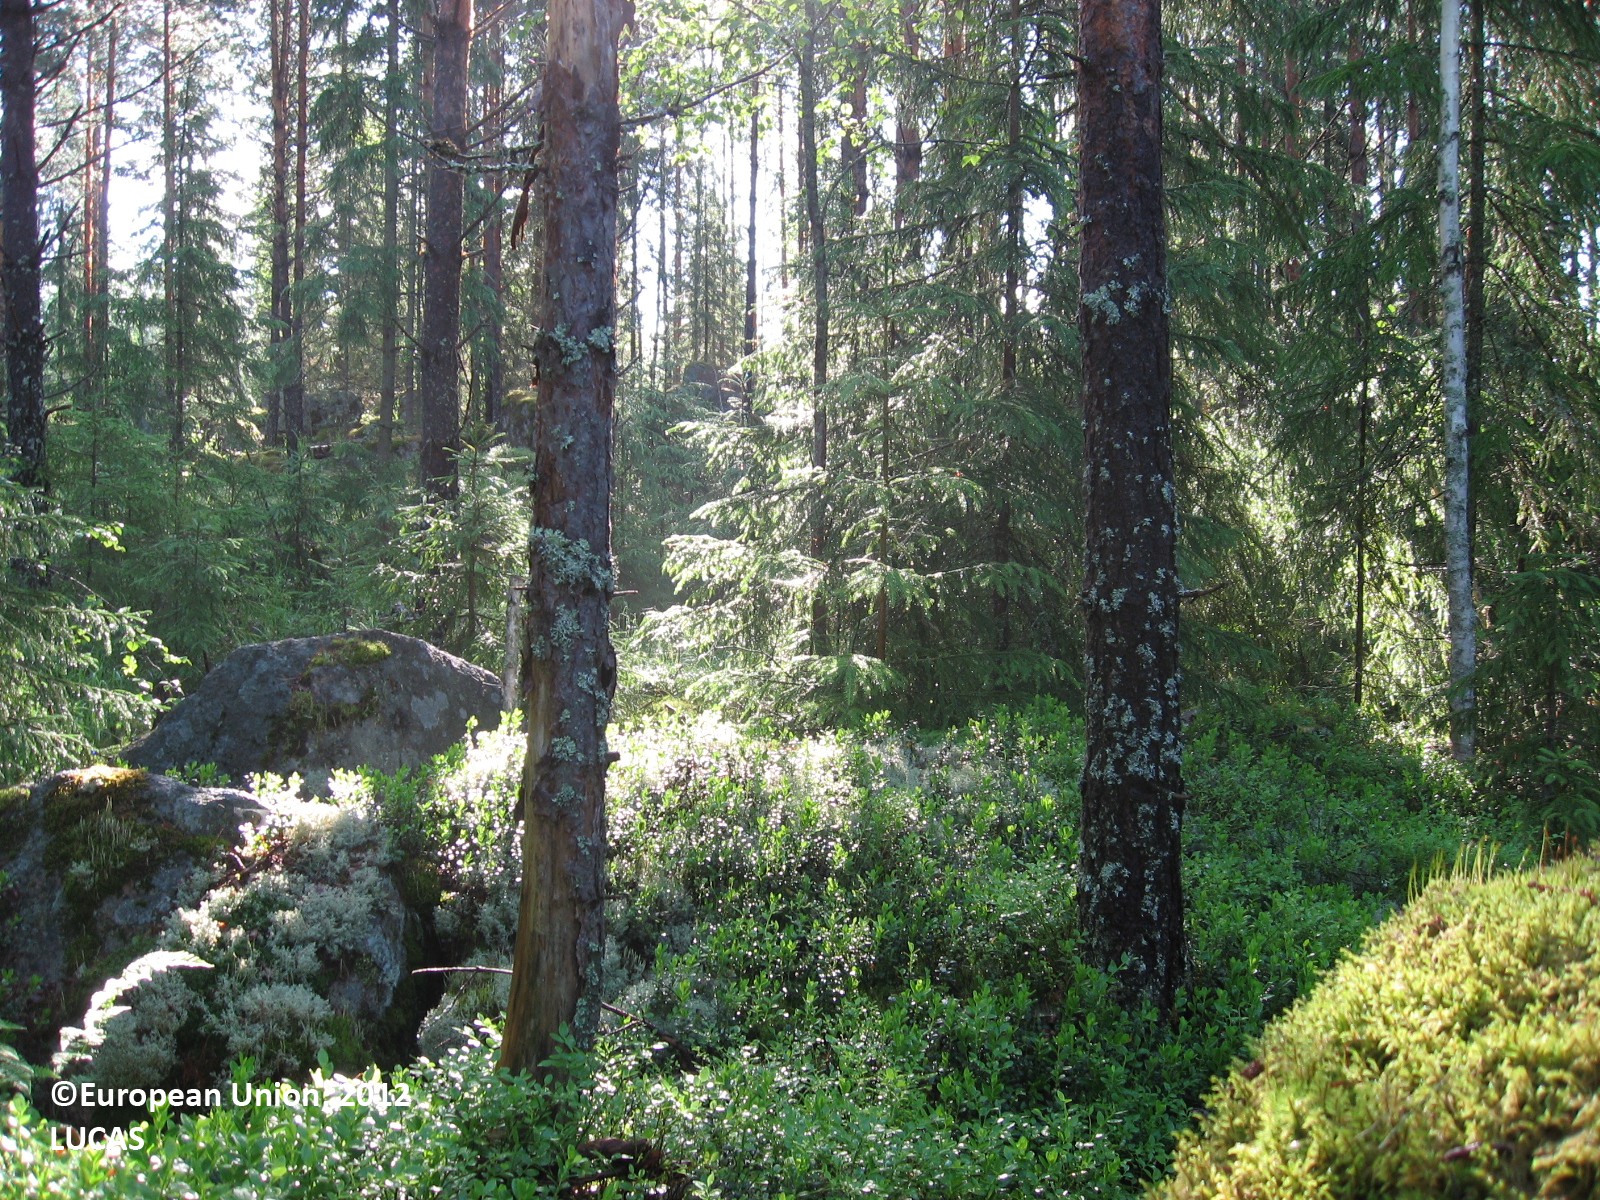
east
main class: Woodland
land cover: Other coniferous woodland
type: boreal forest
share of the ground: 25 - 50 %
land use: Forestry
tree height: > 5 m
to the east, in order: Other coniferous woodland; Spruce dominated mixed woodland; Pine dominated mixed woodland; Spruce dominated mixed woodland; Spontaneously vegetated surfaces; Spruce dominated mixed woodland; Broadleaved woodland
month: June
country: FI
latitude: 60.6394
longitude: 26.3316
